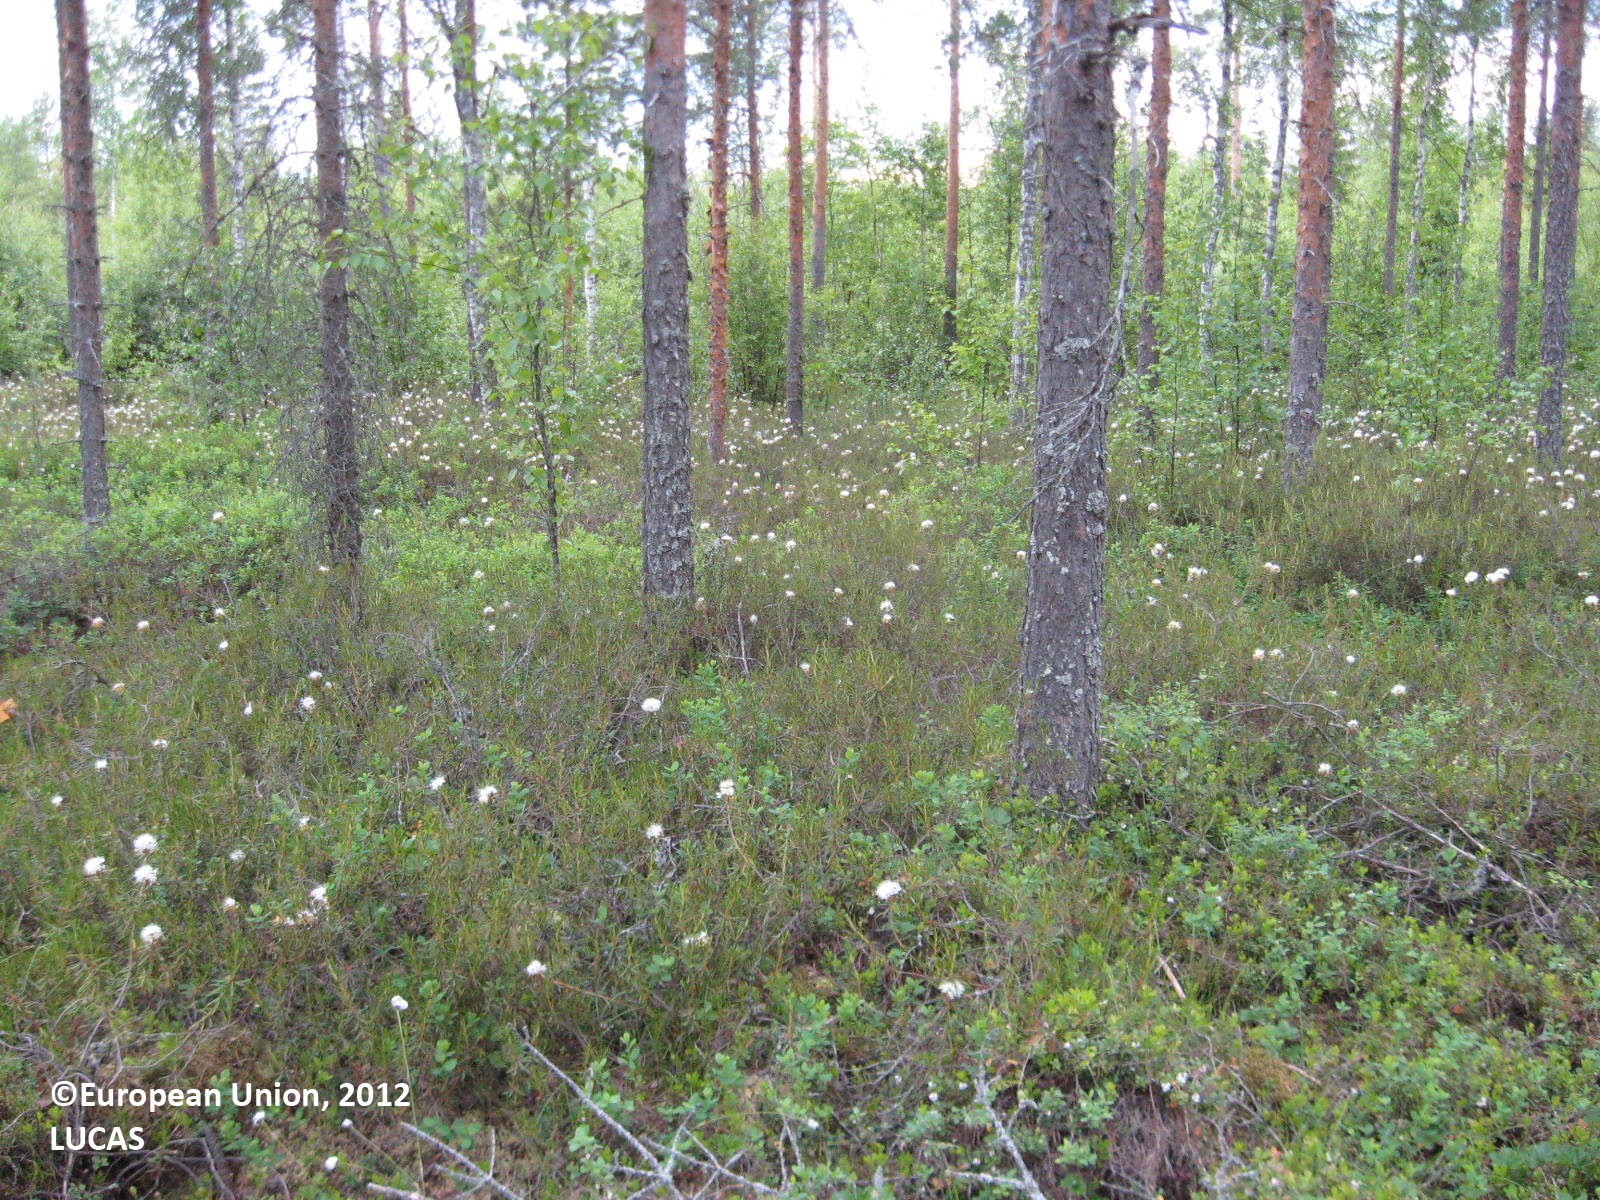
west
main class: Woodland
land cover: Pine dominated coniferous woodland
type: boreal forest
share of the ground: > 75 %
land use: Forestry
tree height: > 5 m
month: June
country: FI
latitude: 63.0081
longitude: 22.6736
